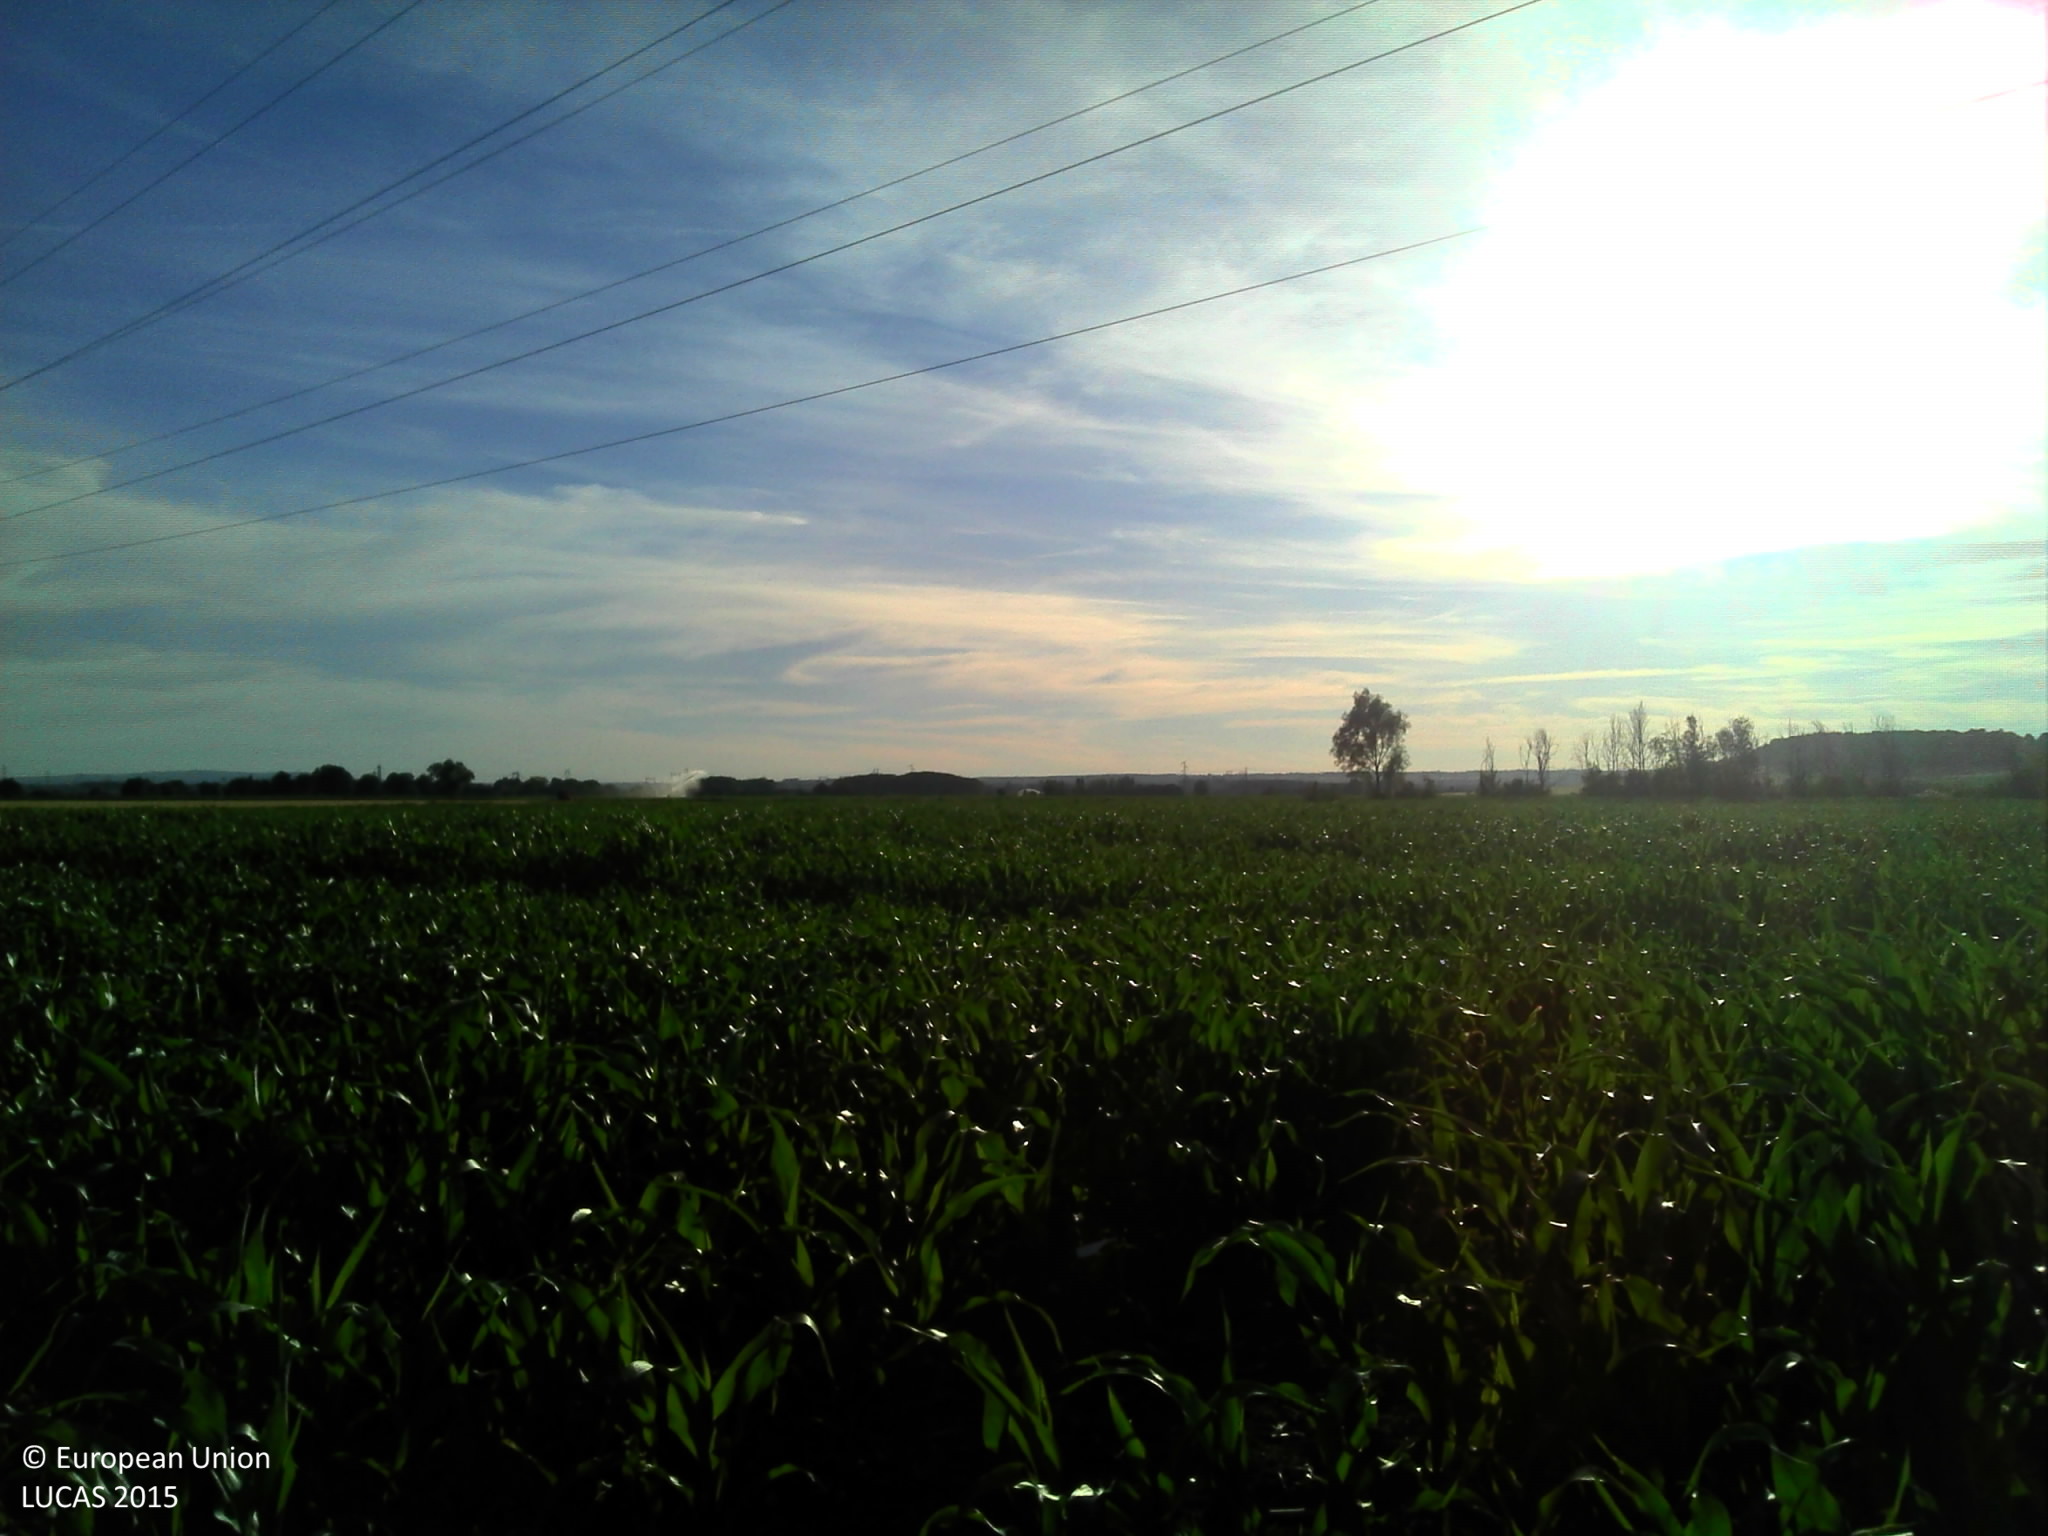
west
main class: Cropland
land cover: Maize
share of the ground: 50 - 75 %
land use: Agriculture (excluding fallow land and kitchen gardens)
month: June
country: FR
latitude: 46.2881
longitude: 3.3402
